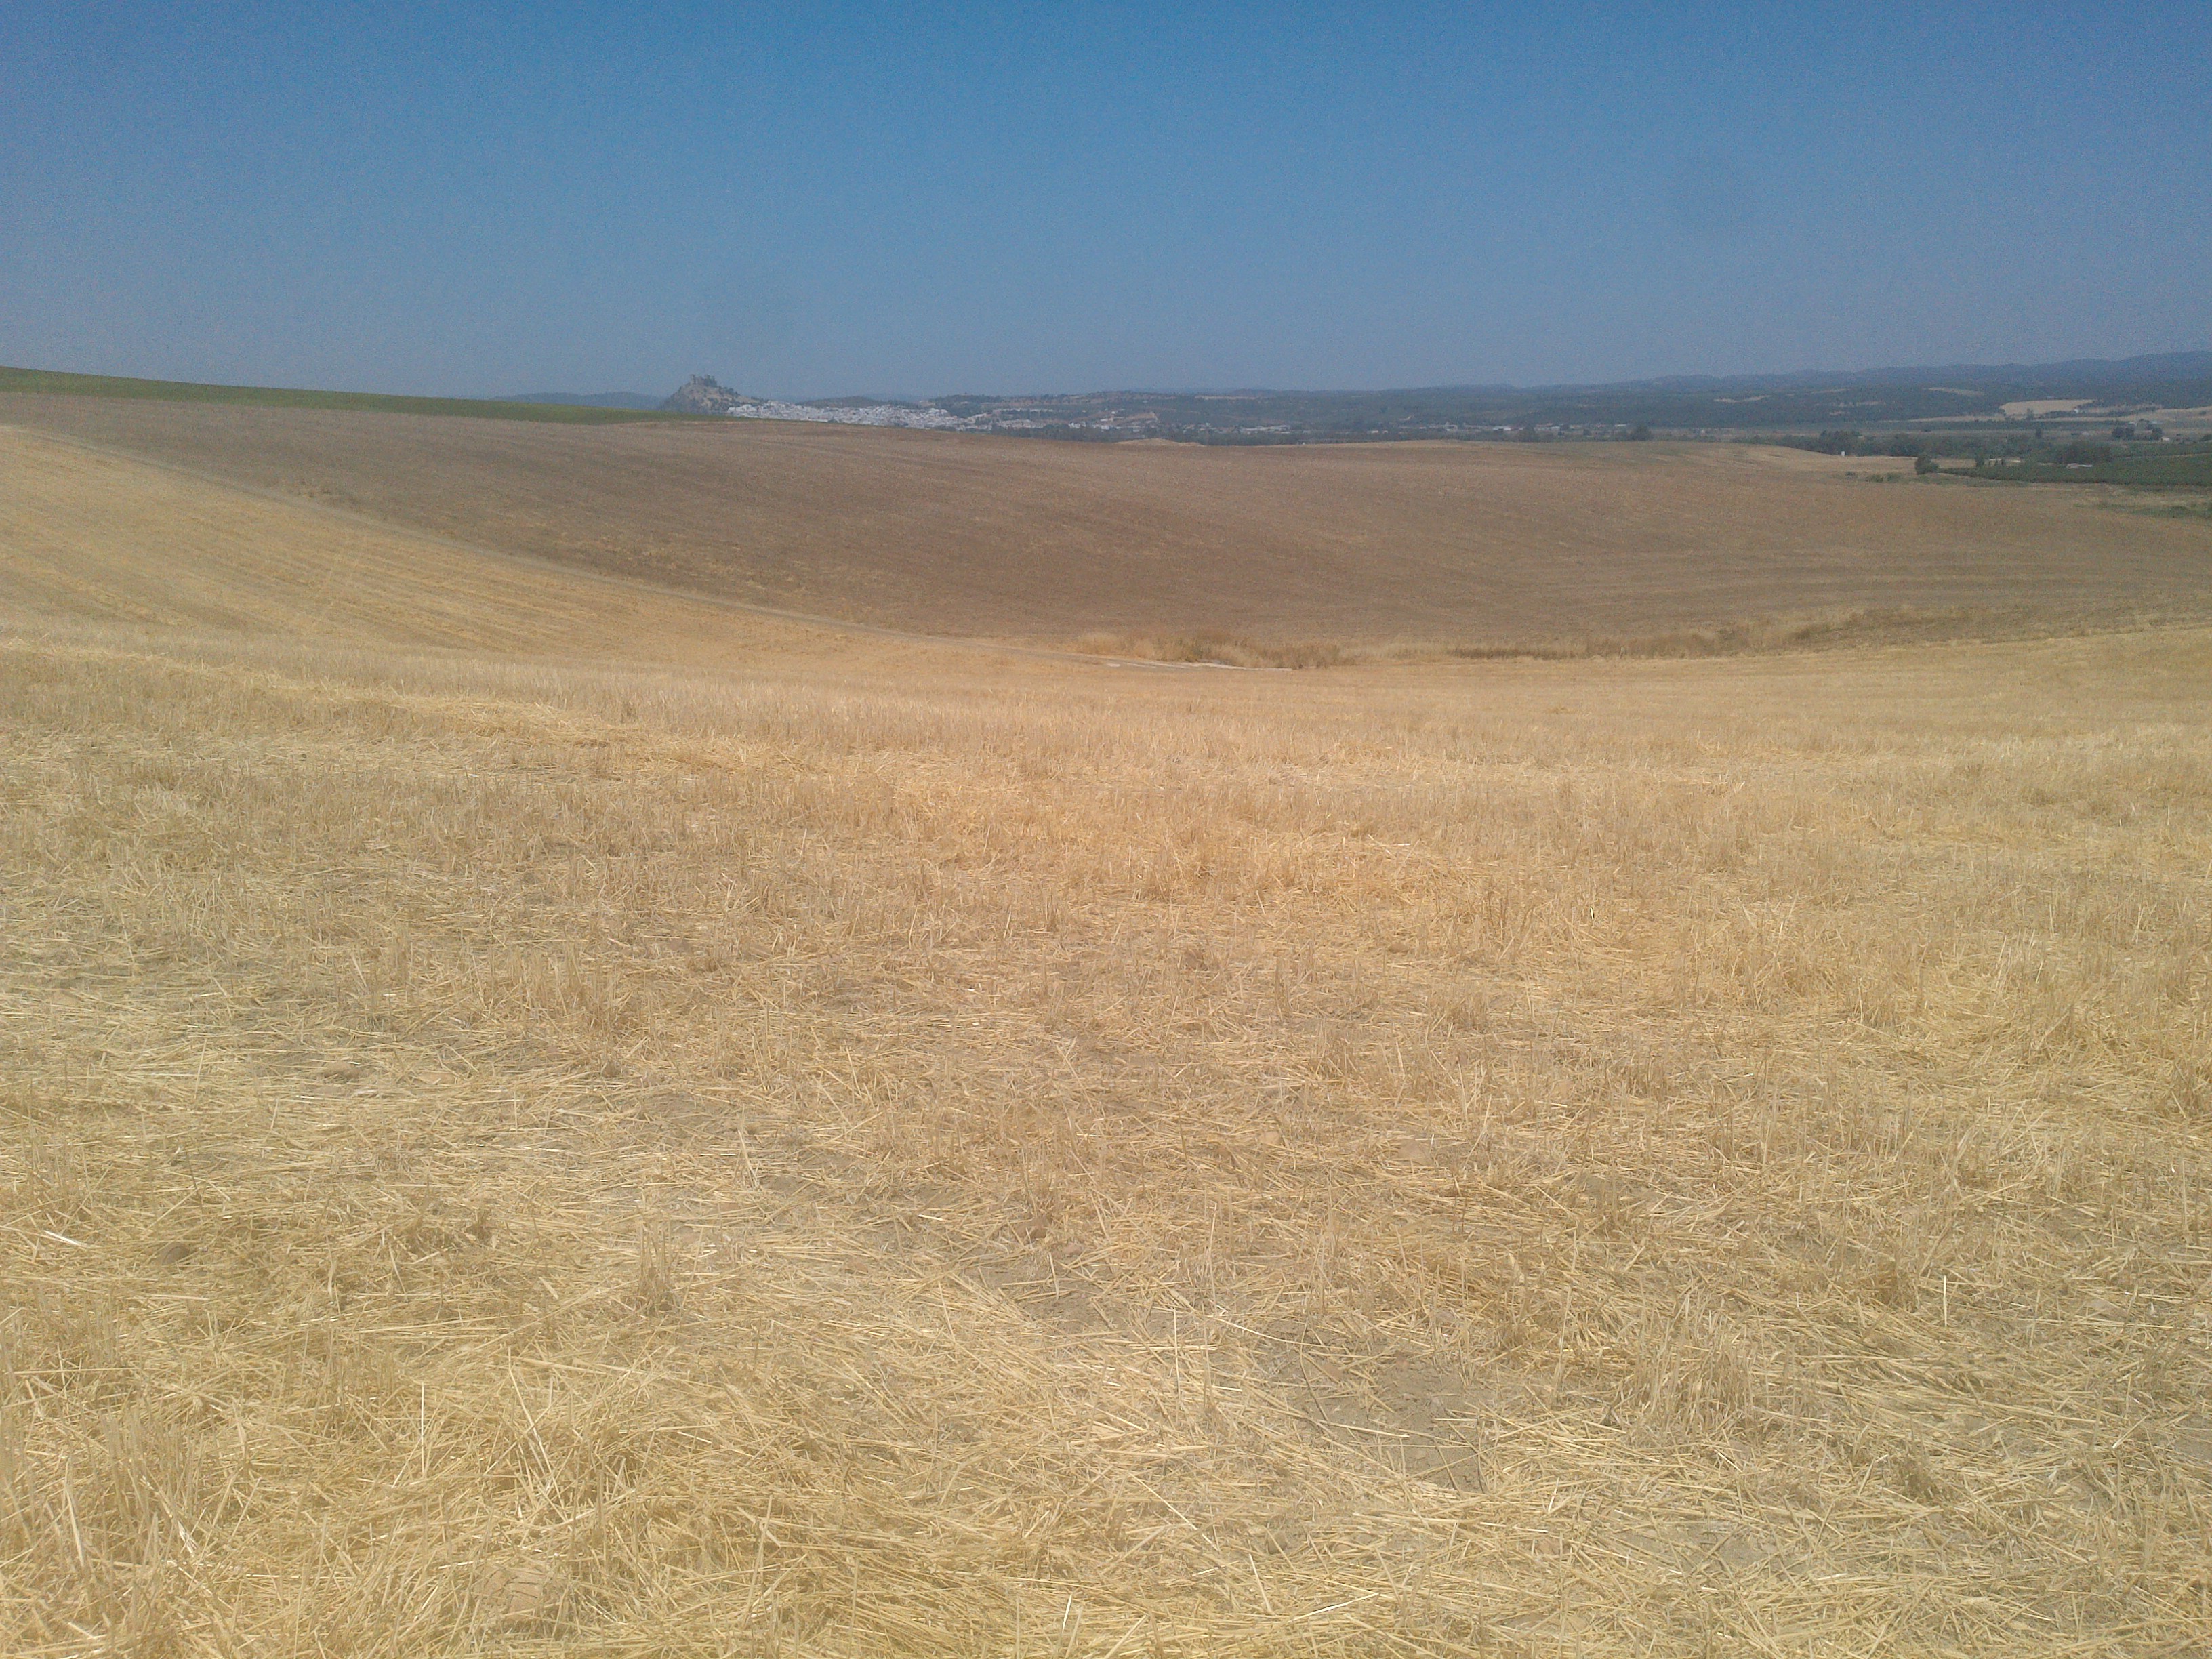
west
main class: Cropland
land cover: Durum wheat
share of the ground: < 10 %
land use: Agriculture (excluding fallow land and kitchen gardens)
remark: Harvested field
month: June
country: ES
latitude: 37.7916
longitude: -4.9481
